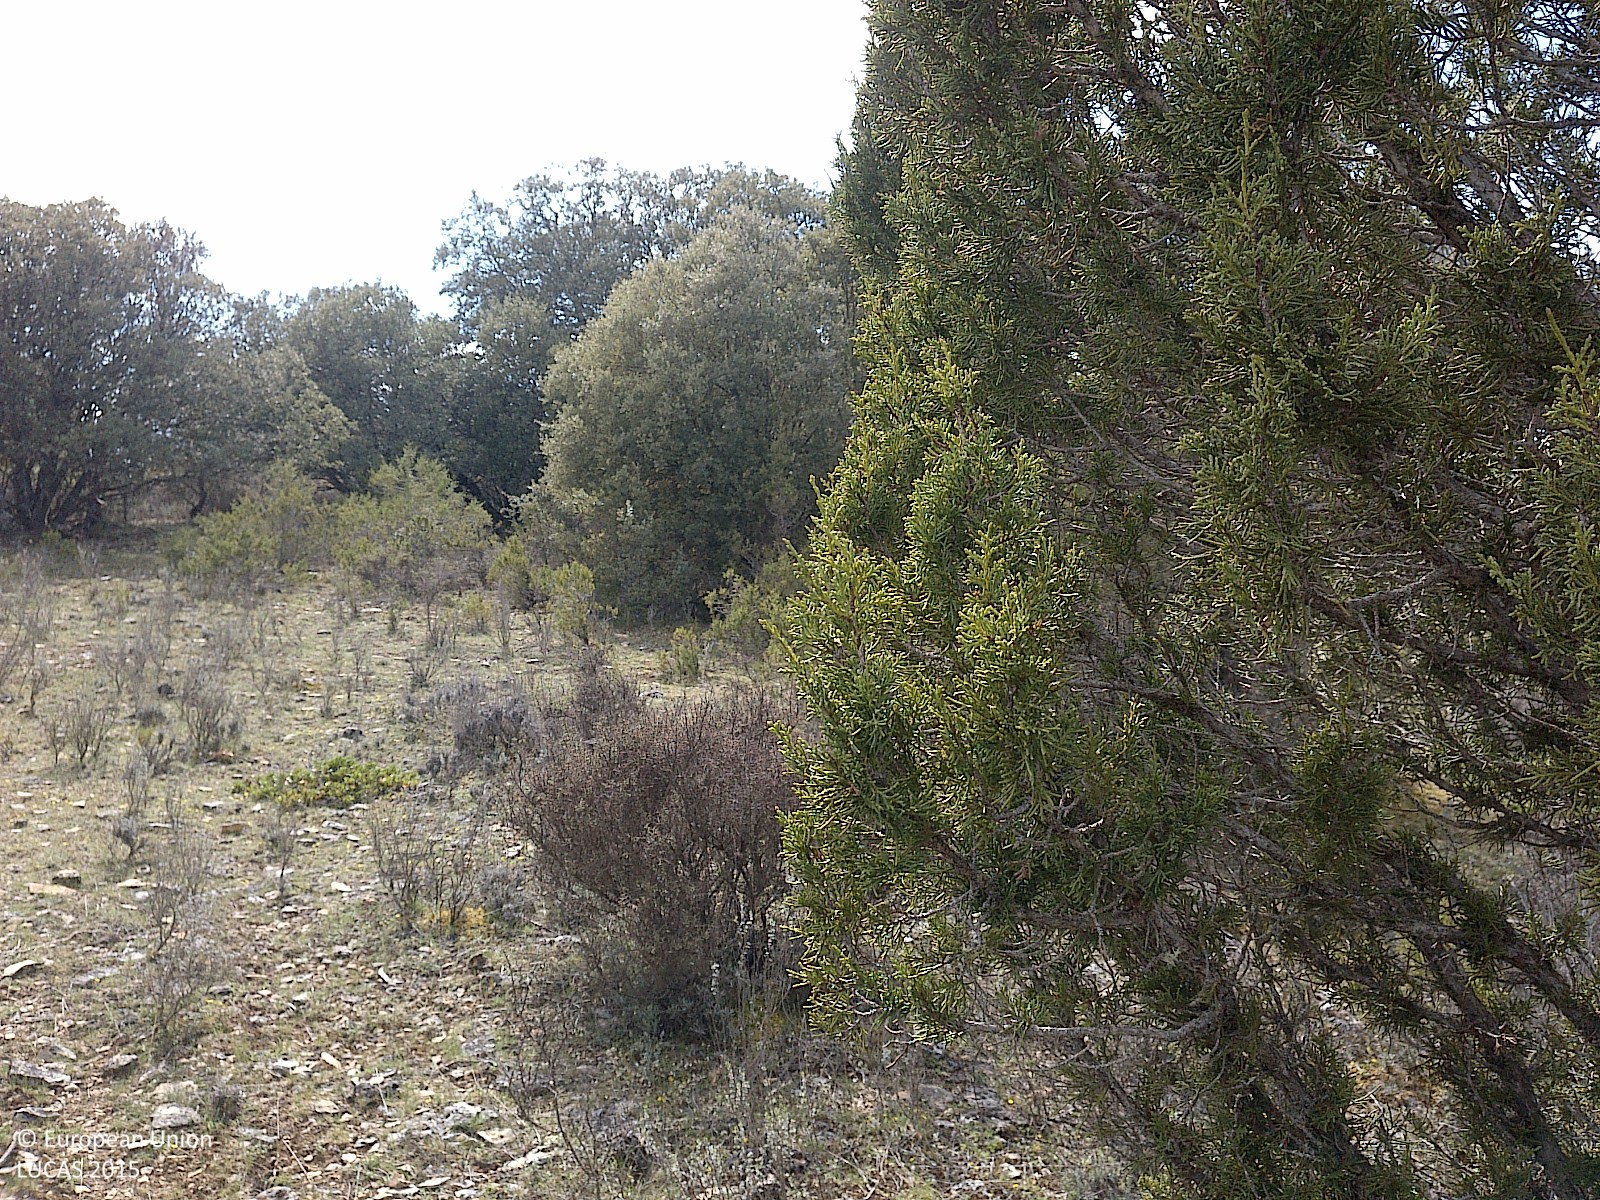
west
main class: Woodland
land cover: Other mixed woodland
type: coniferous forest of the mediterranean region
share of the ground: 50 - 75 %
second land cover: Spontaneously vegetated surfaces
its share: 50 - 75 %
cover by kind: coniferous forest trees 45 %, herbaceous plants 30 %, broadleaved forest trees 20 %, shrubs 5 %
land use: Forestry
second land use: Agriculture (excluding fallow land and kitchen gardens)
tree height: < 5 m
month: April
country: ES
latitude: 41.9544
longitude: -3.5784
